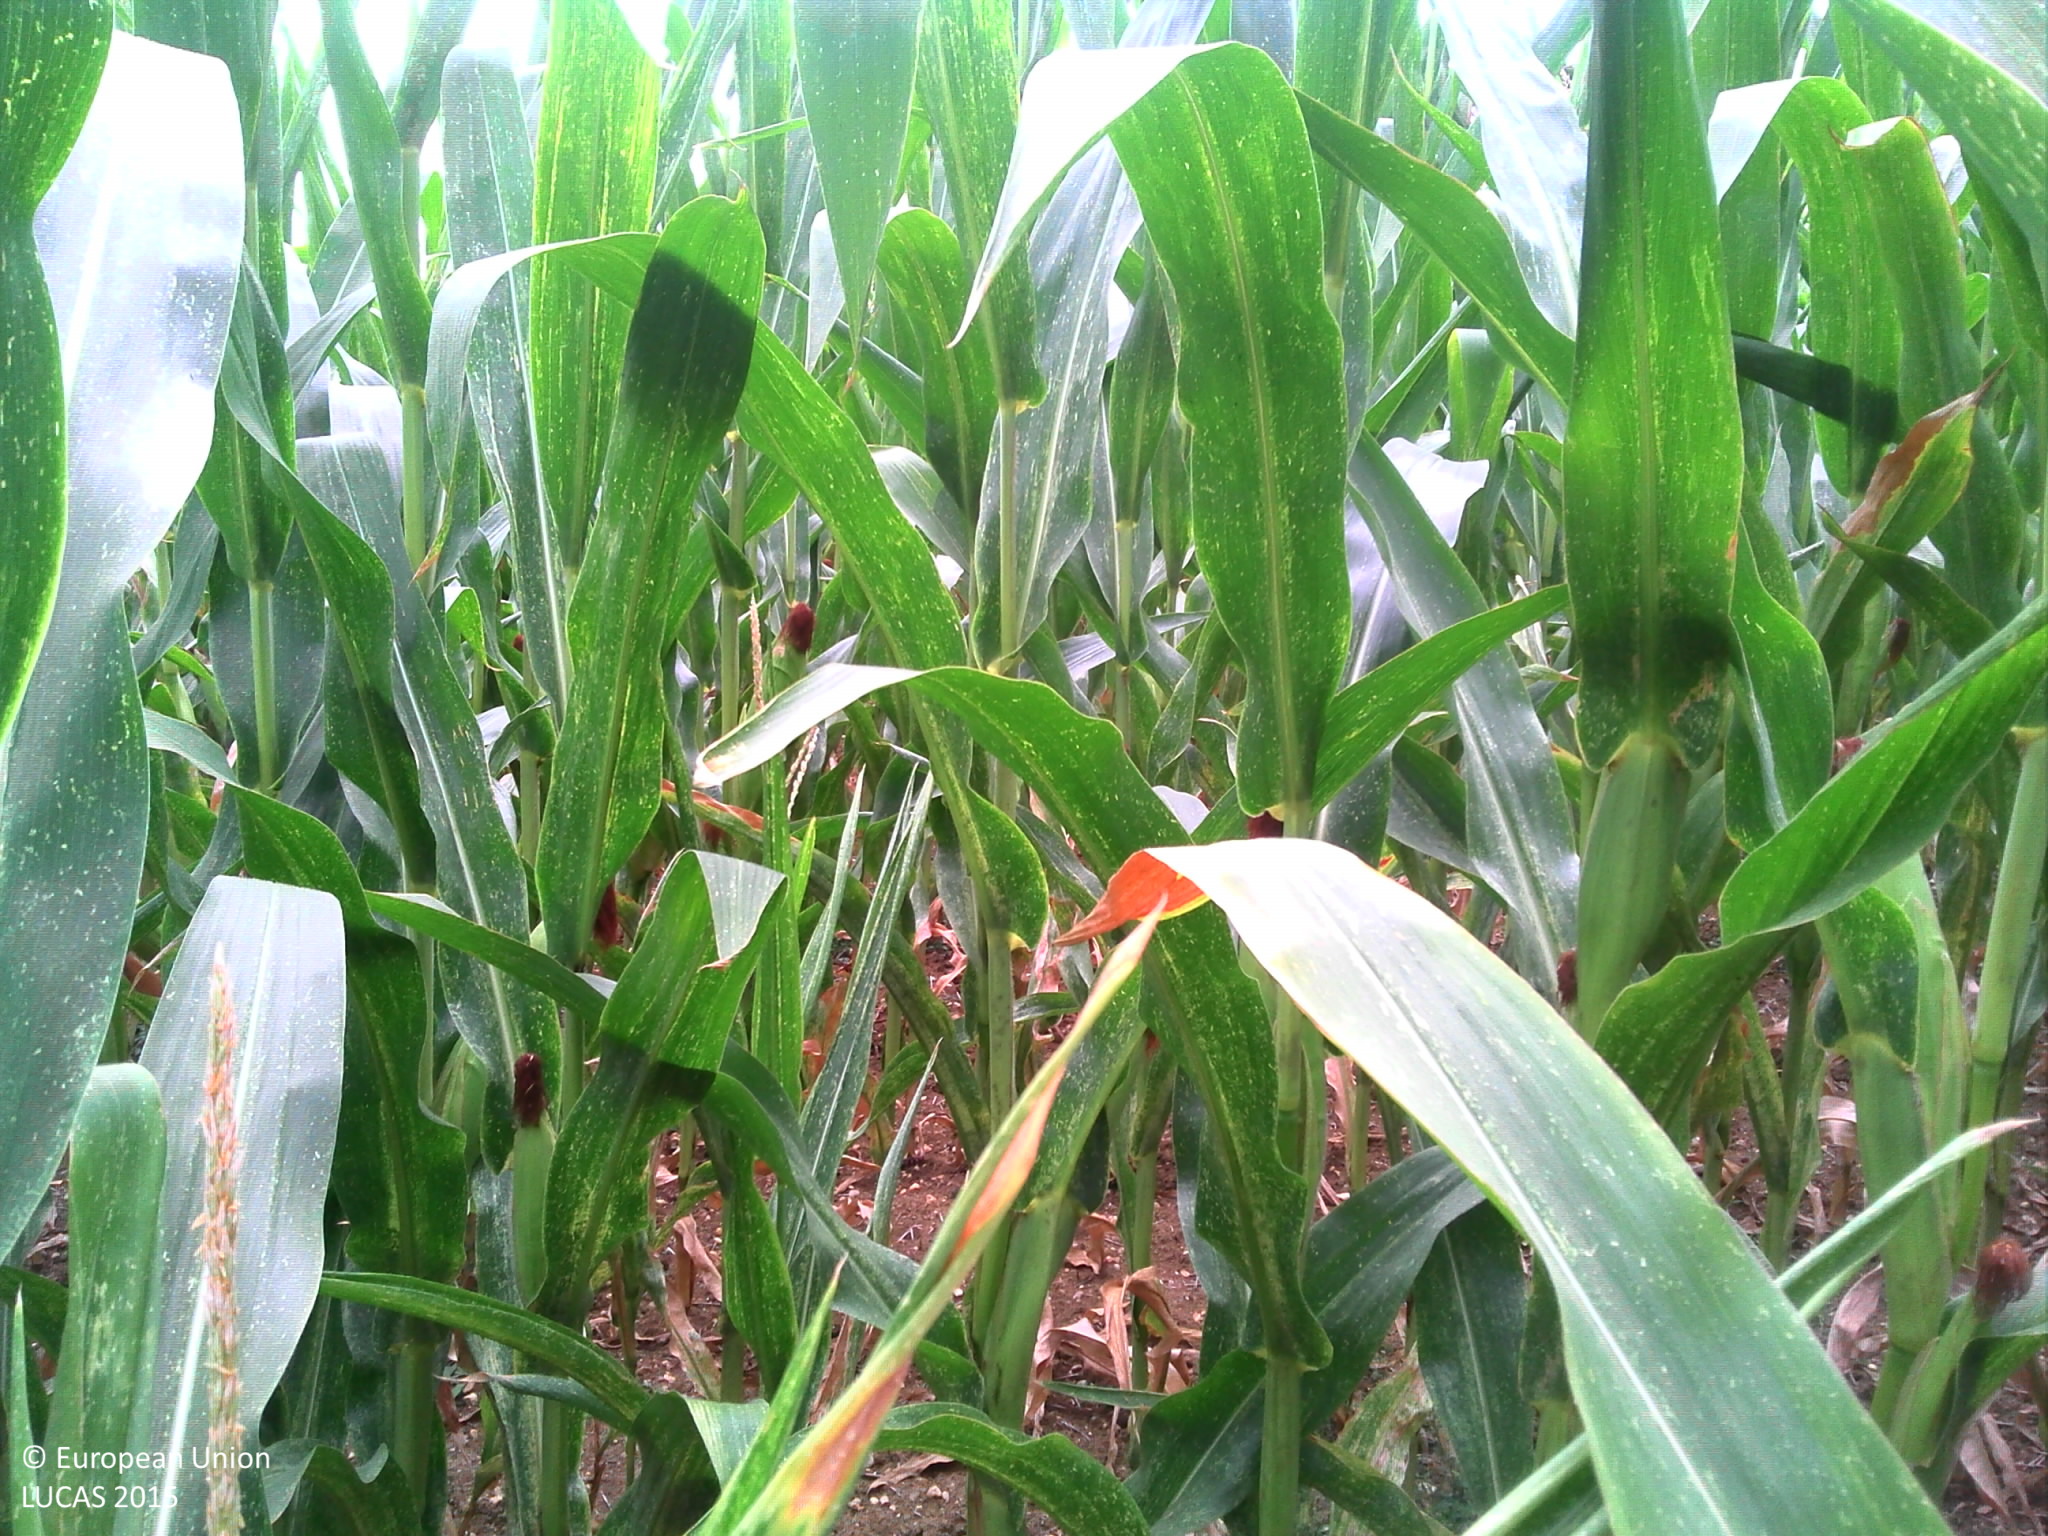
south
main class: Cropland
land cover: Maize
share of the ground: > 75 %
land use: Agriculture (excluding fallow land and kitchen gardens)
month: July
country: FR
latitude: 44.0878
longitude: 0.6158
